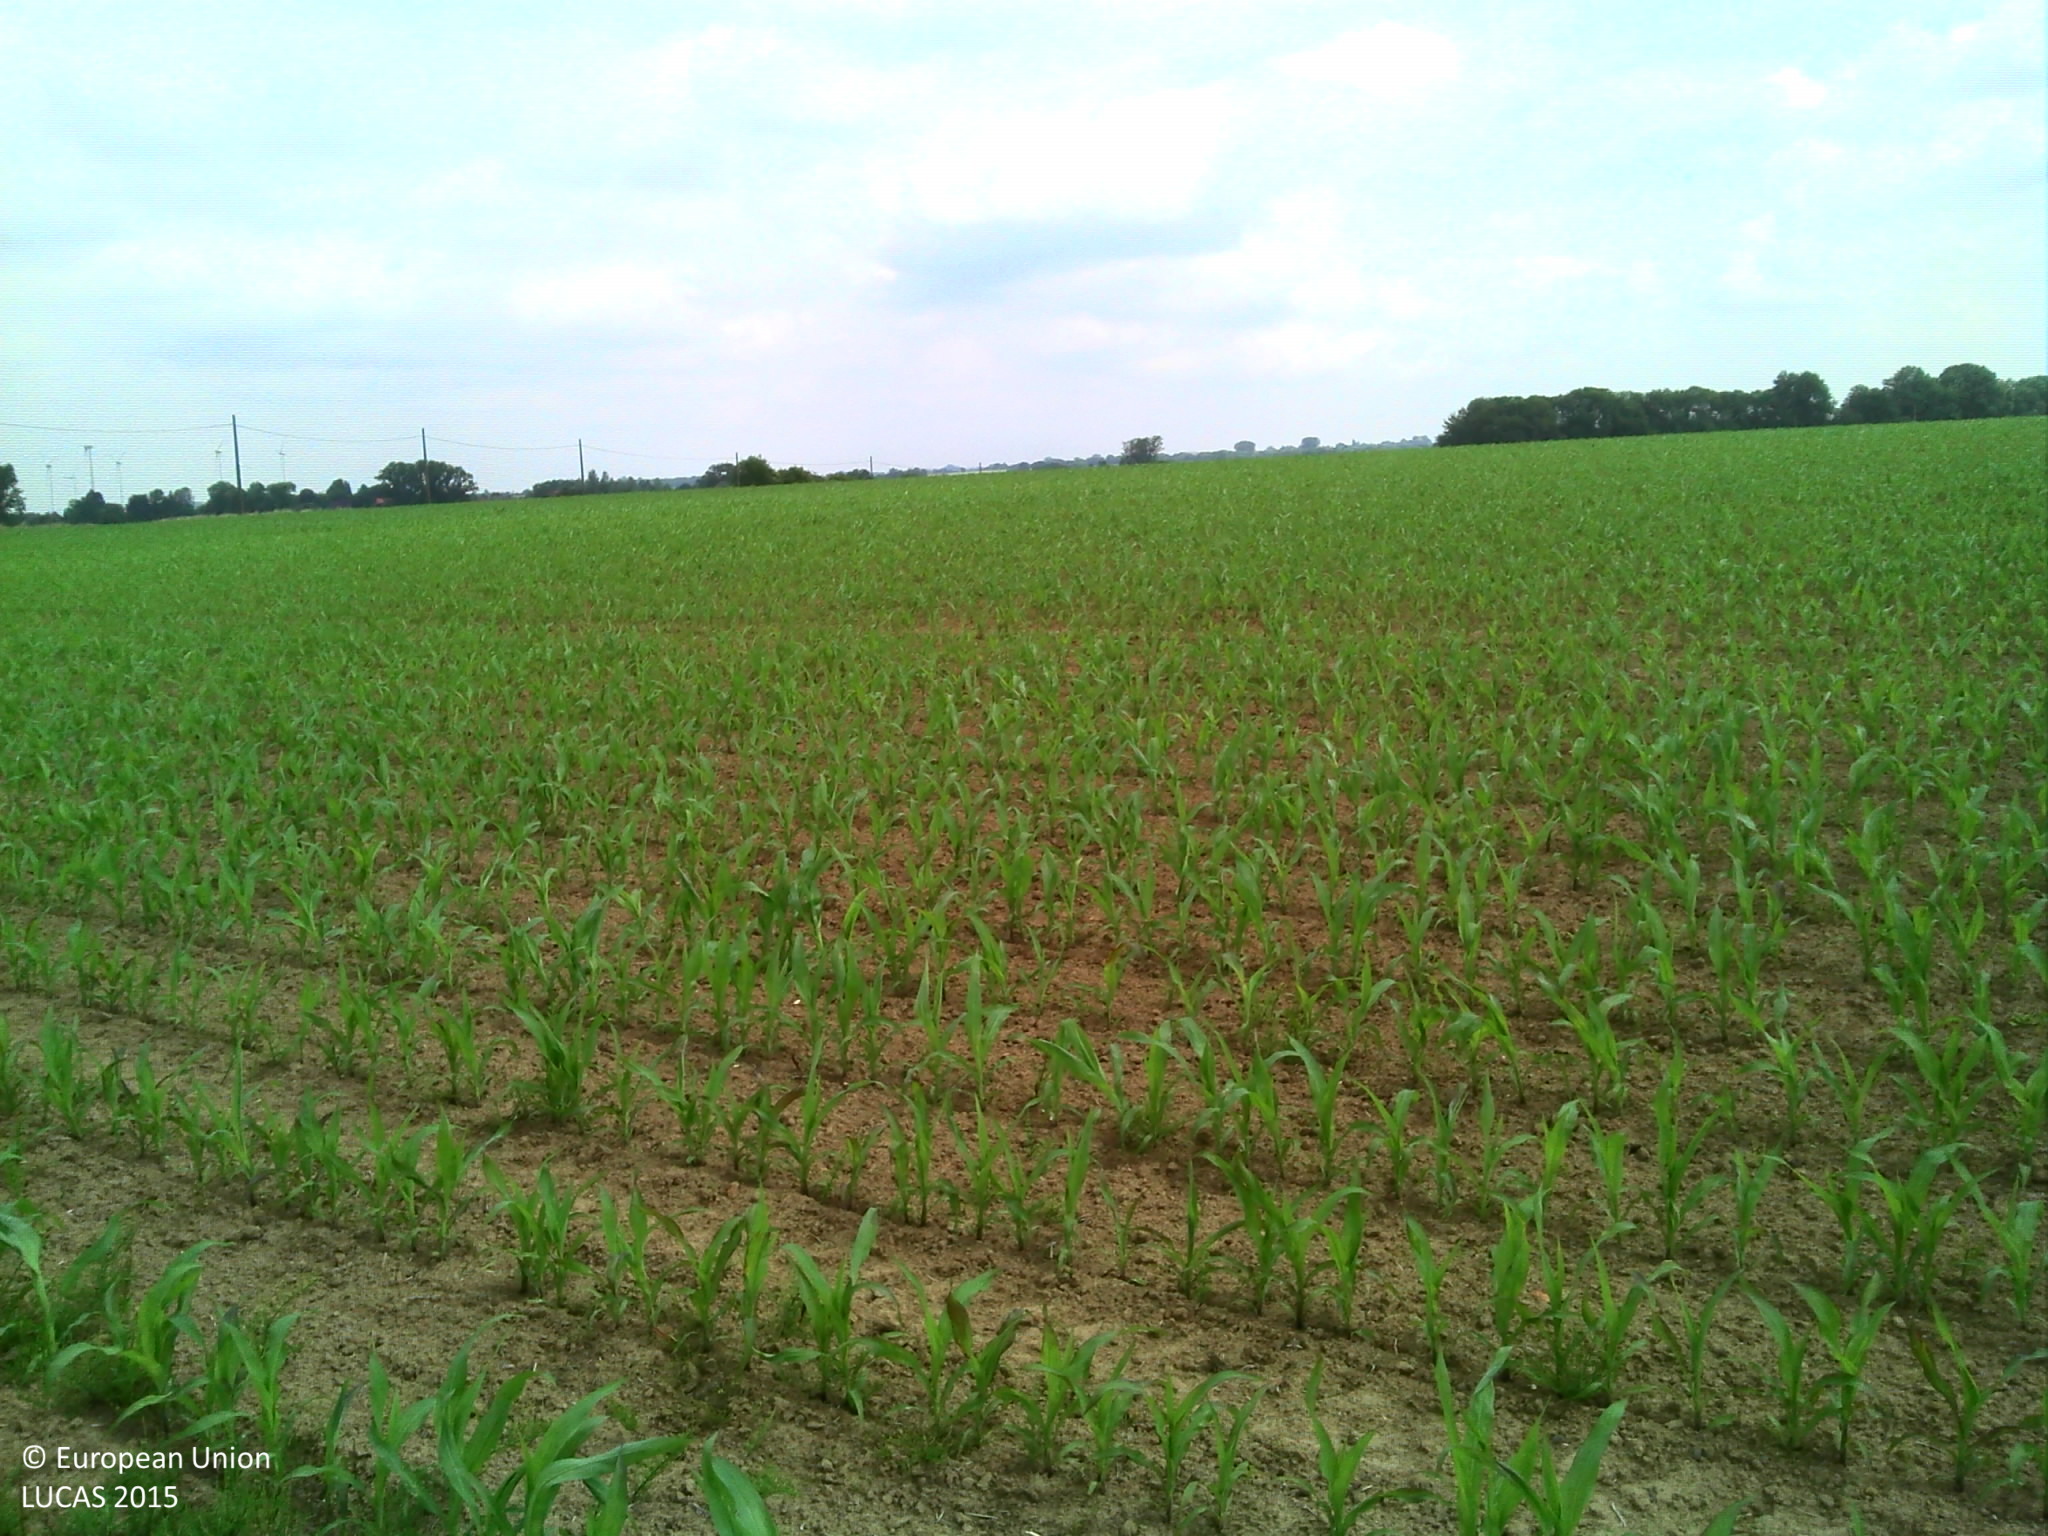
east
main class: Grassland
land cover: Grassland with sparse tree/shrub cover
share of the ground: > 75 %
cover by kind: herbaceous plants 95 %, broadleaved forest trees 5 %
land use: Residential
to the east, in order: Grassland with sparse tree/shrub cover; Fences; Maize; Other fibre and oleaginous crops
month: June
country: BE
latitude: 50.3876
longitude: 3.6779
